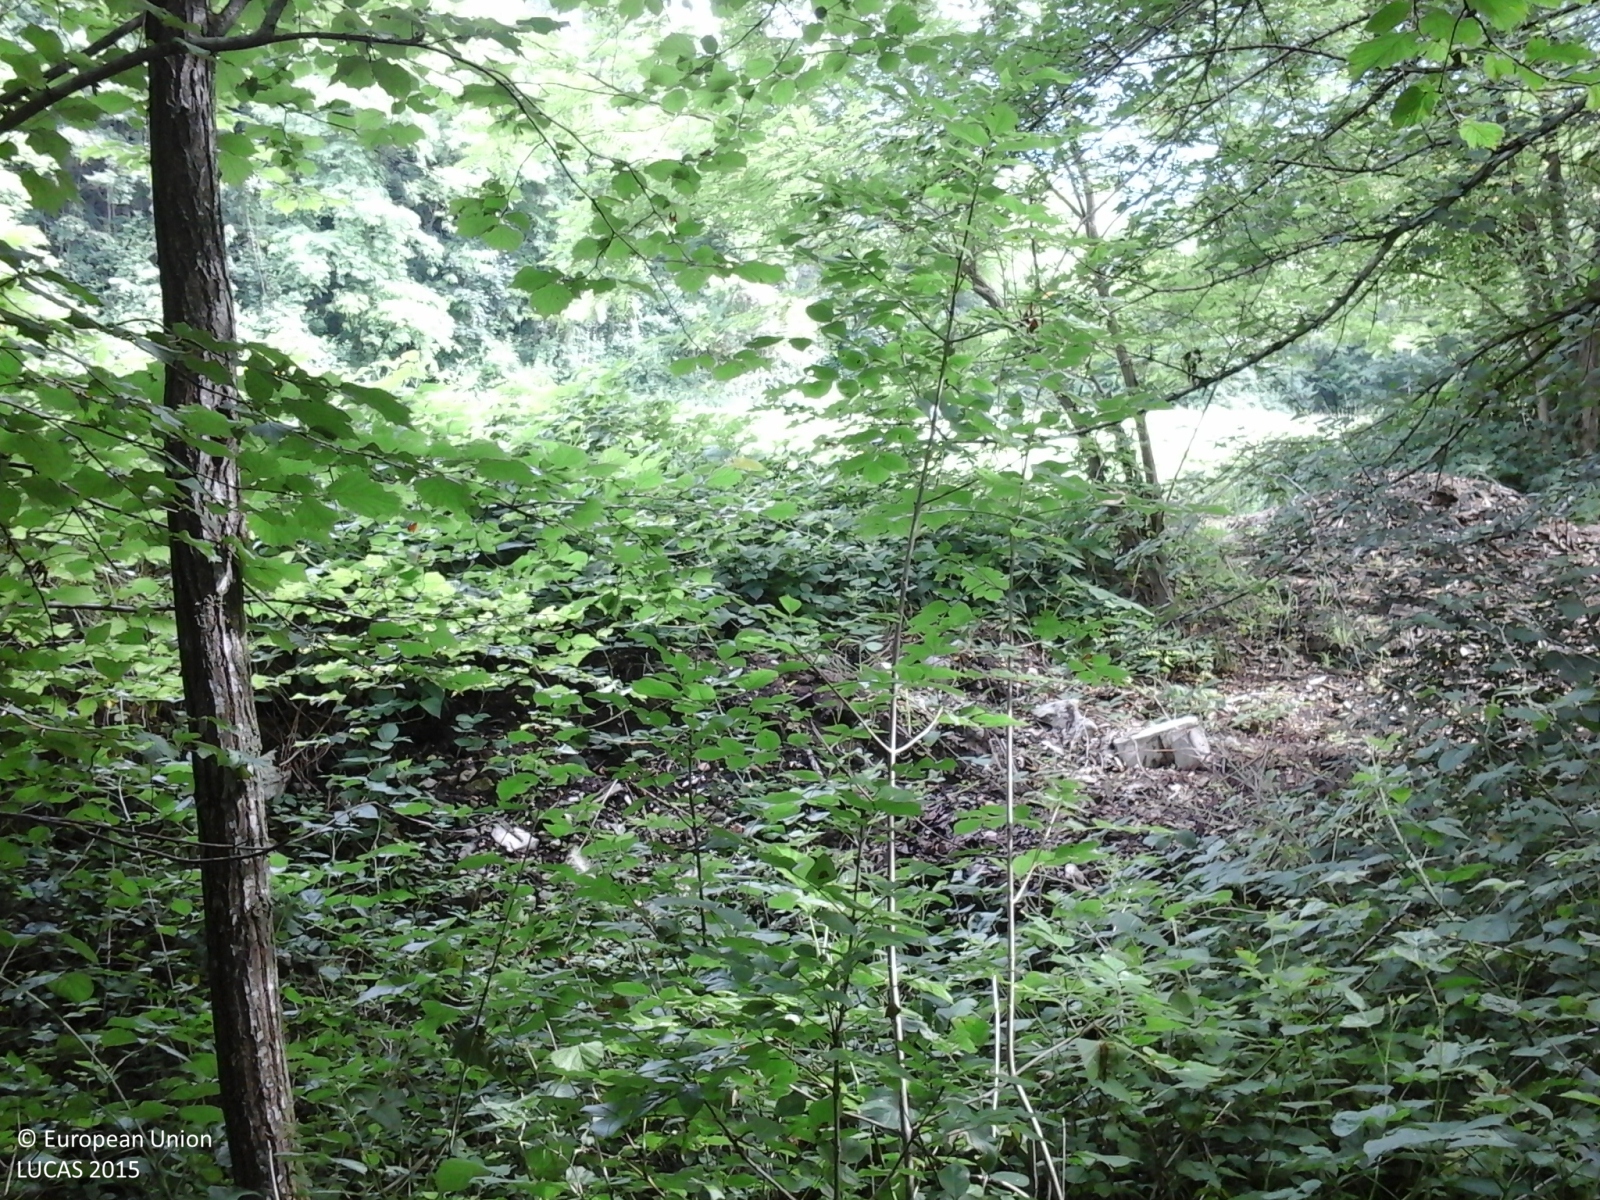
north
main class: Woodland
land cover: Broadleaved woodland
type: thermophilous deciduous forest
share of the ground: > 75 %
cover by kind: broadleaved forest trees 100 %
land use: Semi-natural and natural areas not in use
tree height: > 5 m
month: June
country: IT
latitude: 46.0014
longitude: 12.3341
